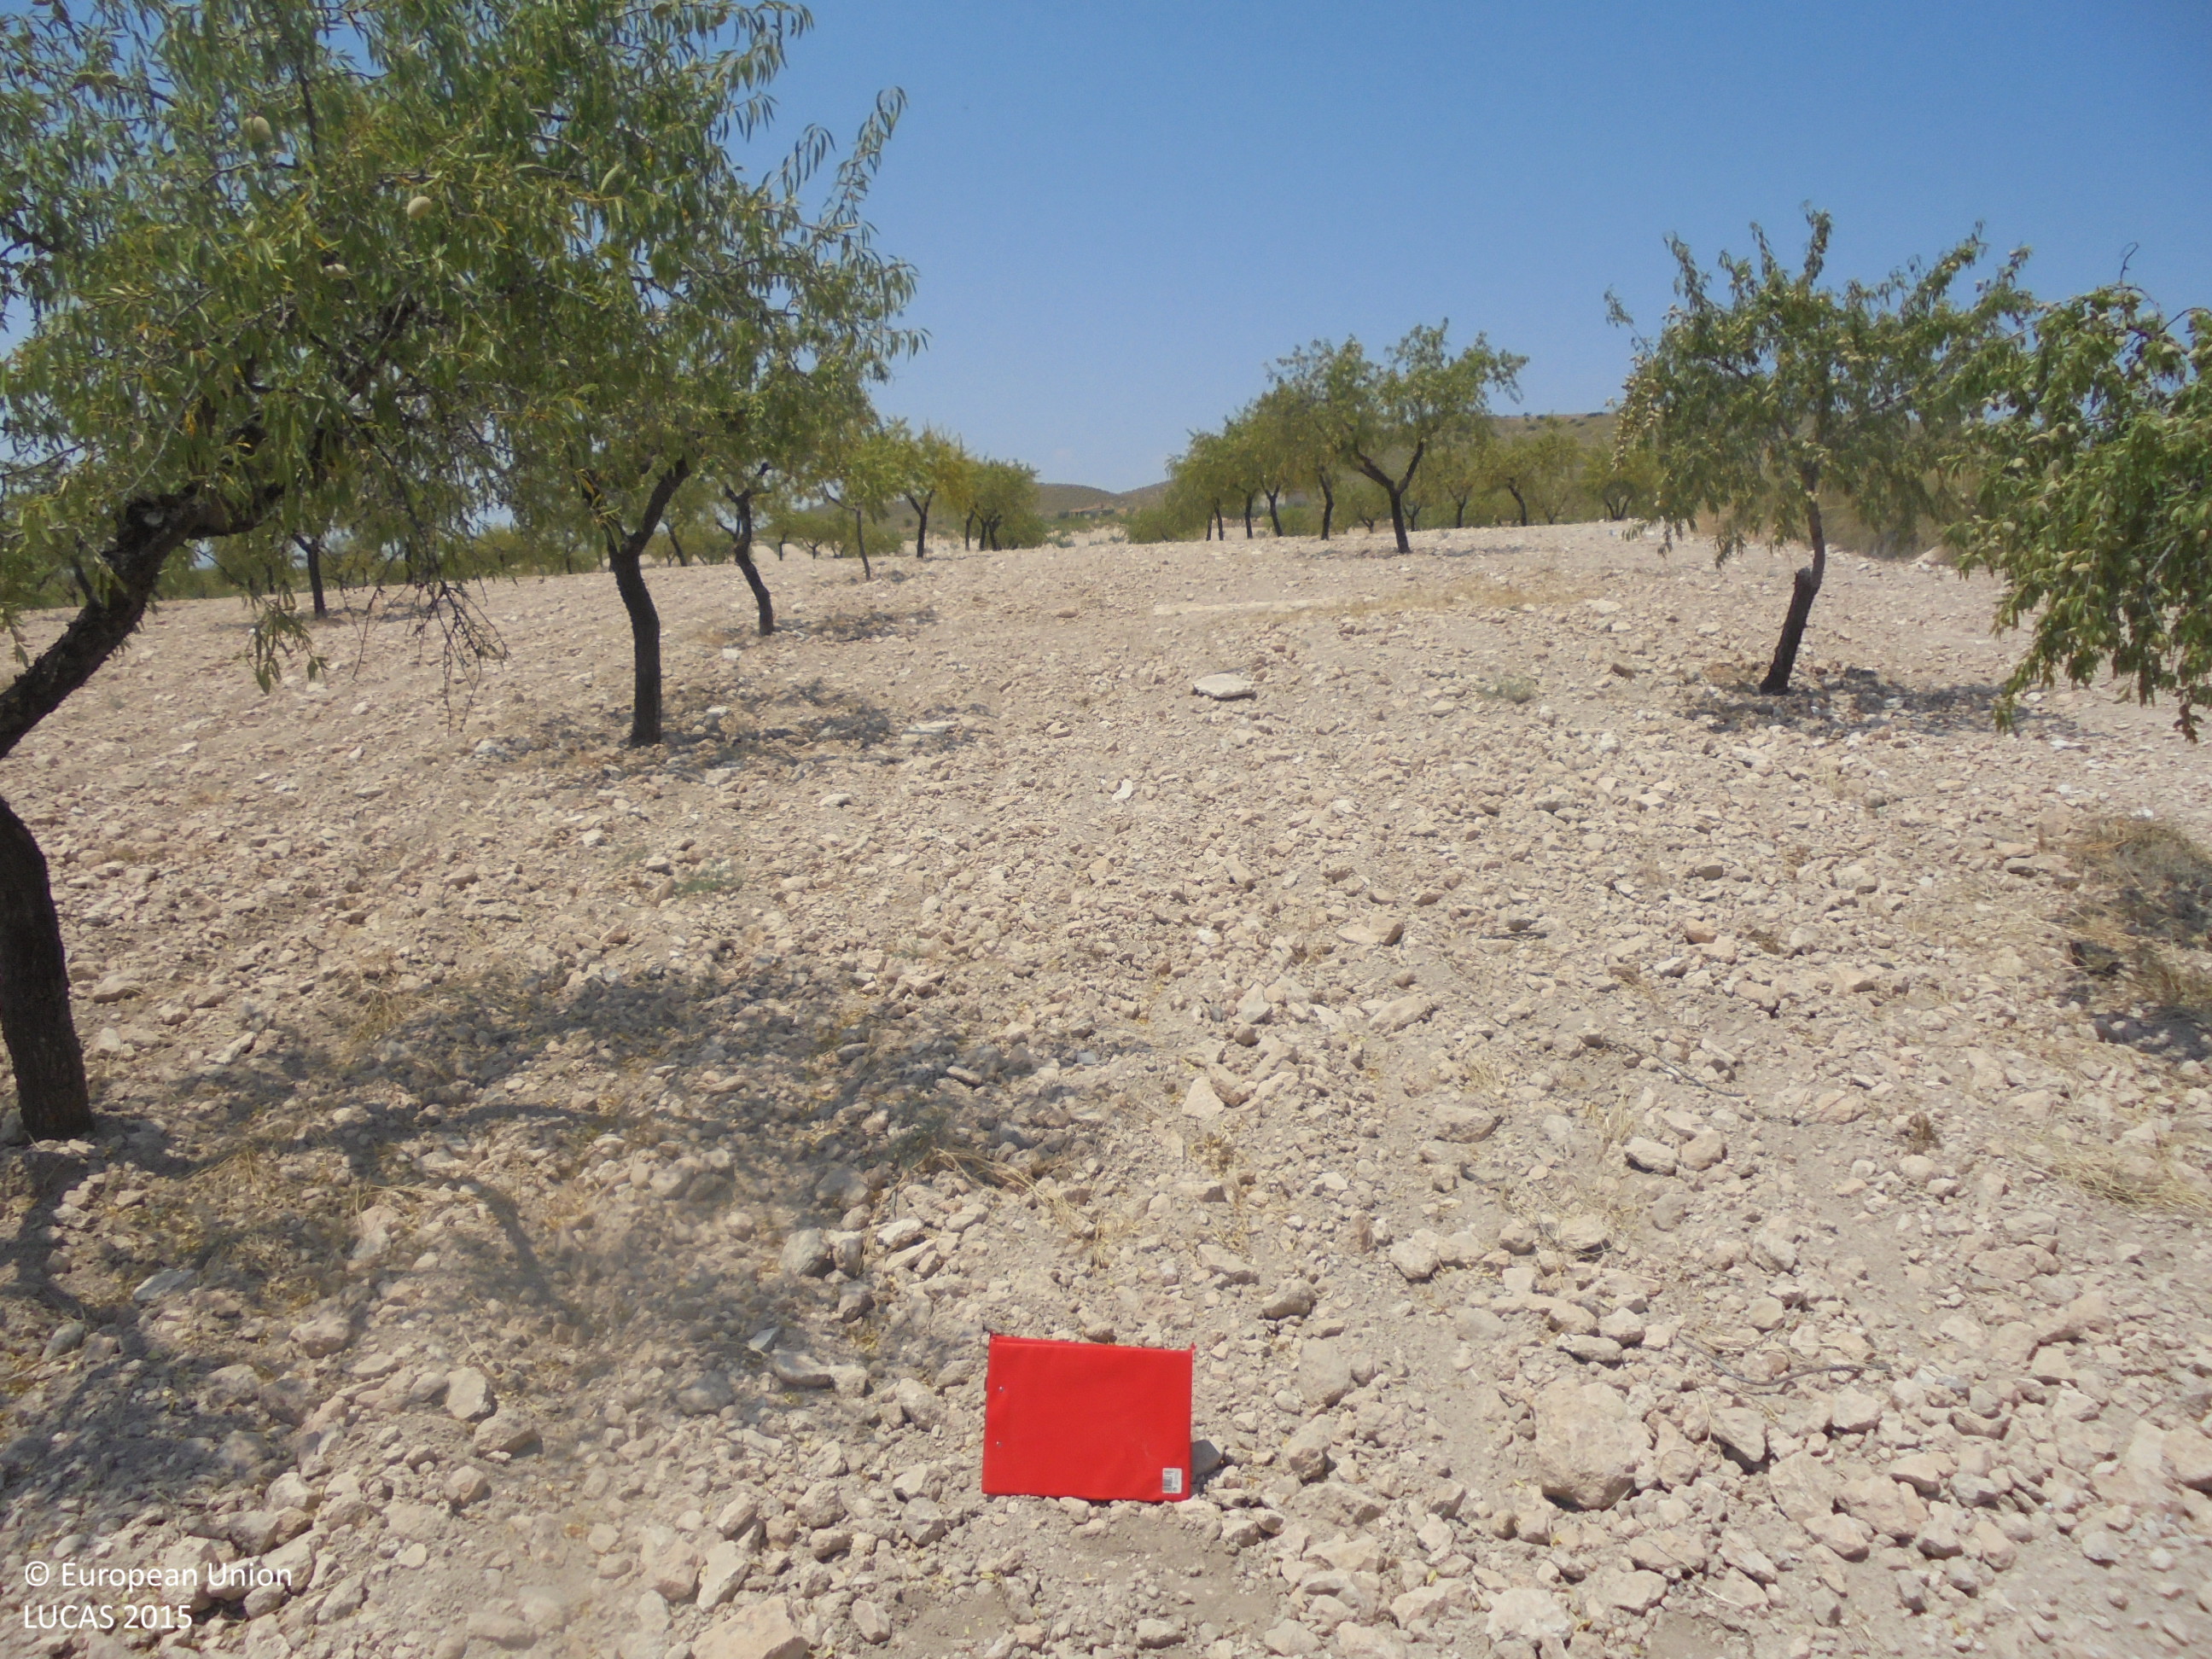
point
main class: Cropland
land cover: Nuts trees
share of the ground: 25 - 50 %
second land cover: Other bare soil
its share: > 75 %
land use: Agriculture (excluding fallow land and kitchen gardens)
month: July
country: ES
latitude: 38.6270
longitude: -1.4454
